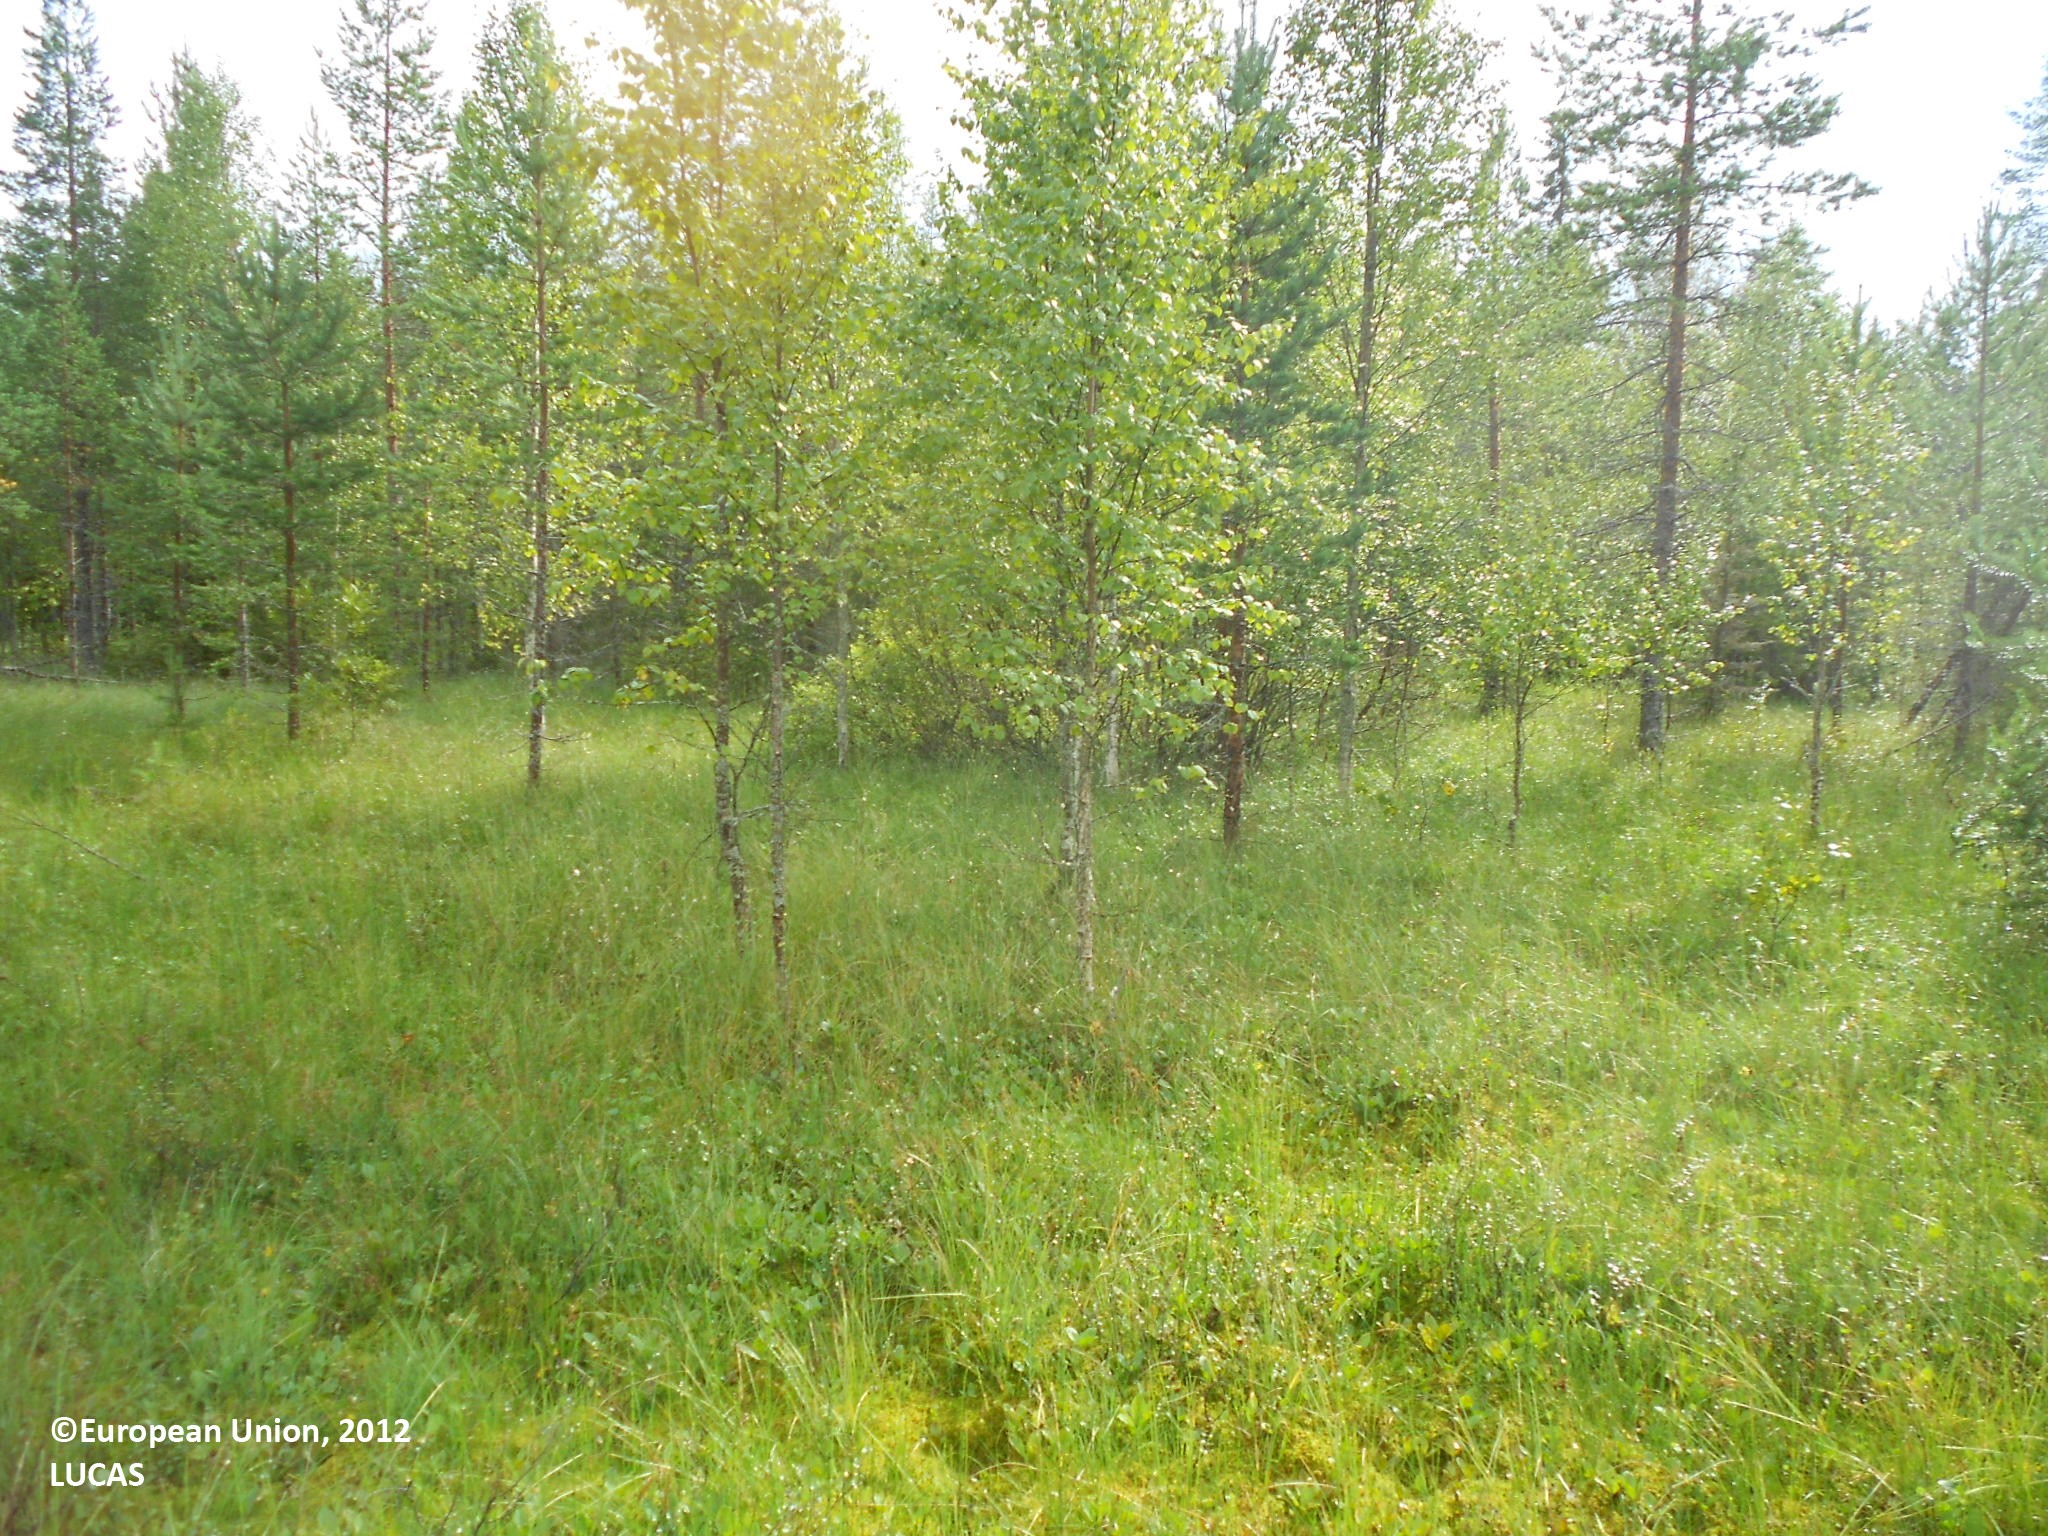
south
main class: Woodland
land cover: Pine dominated coniferous woodland
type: boreal forest
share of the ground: 10 - 25 %
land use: Semi-natural and natural areas not in use
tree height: > 5 m
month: August
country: FI
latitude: 63.5746
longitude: 28.4958
